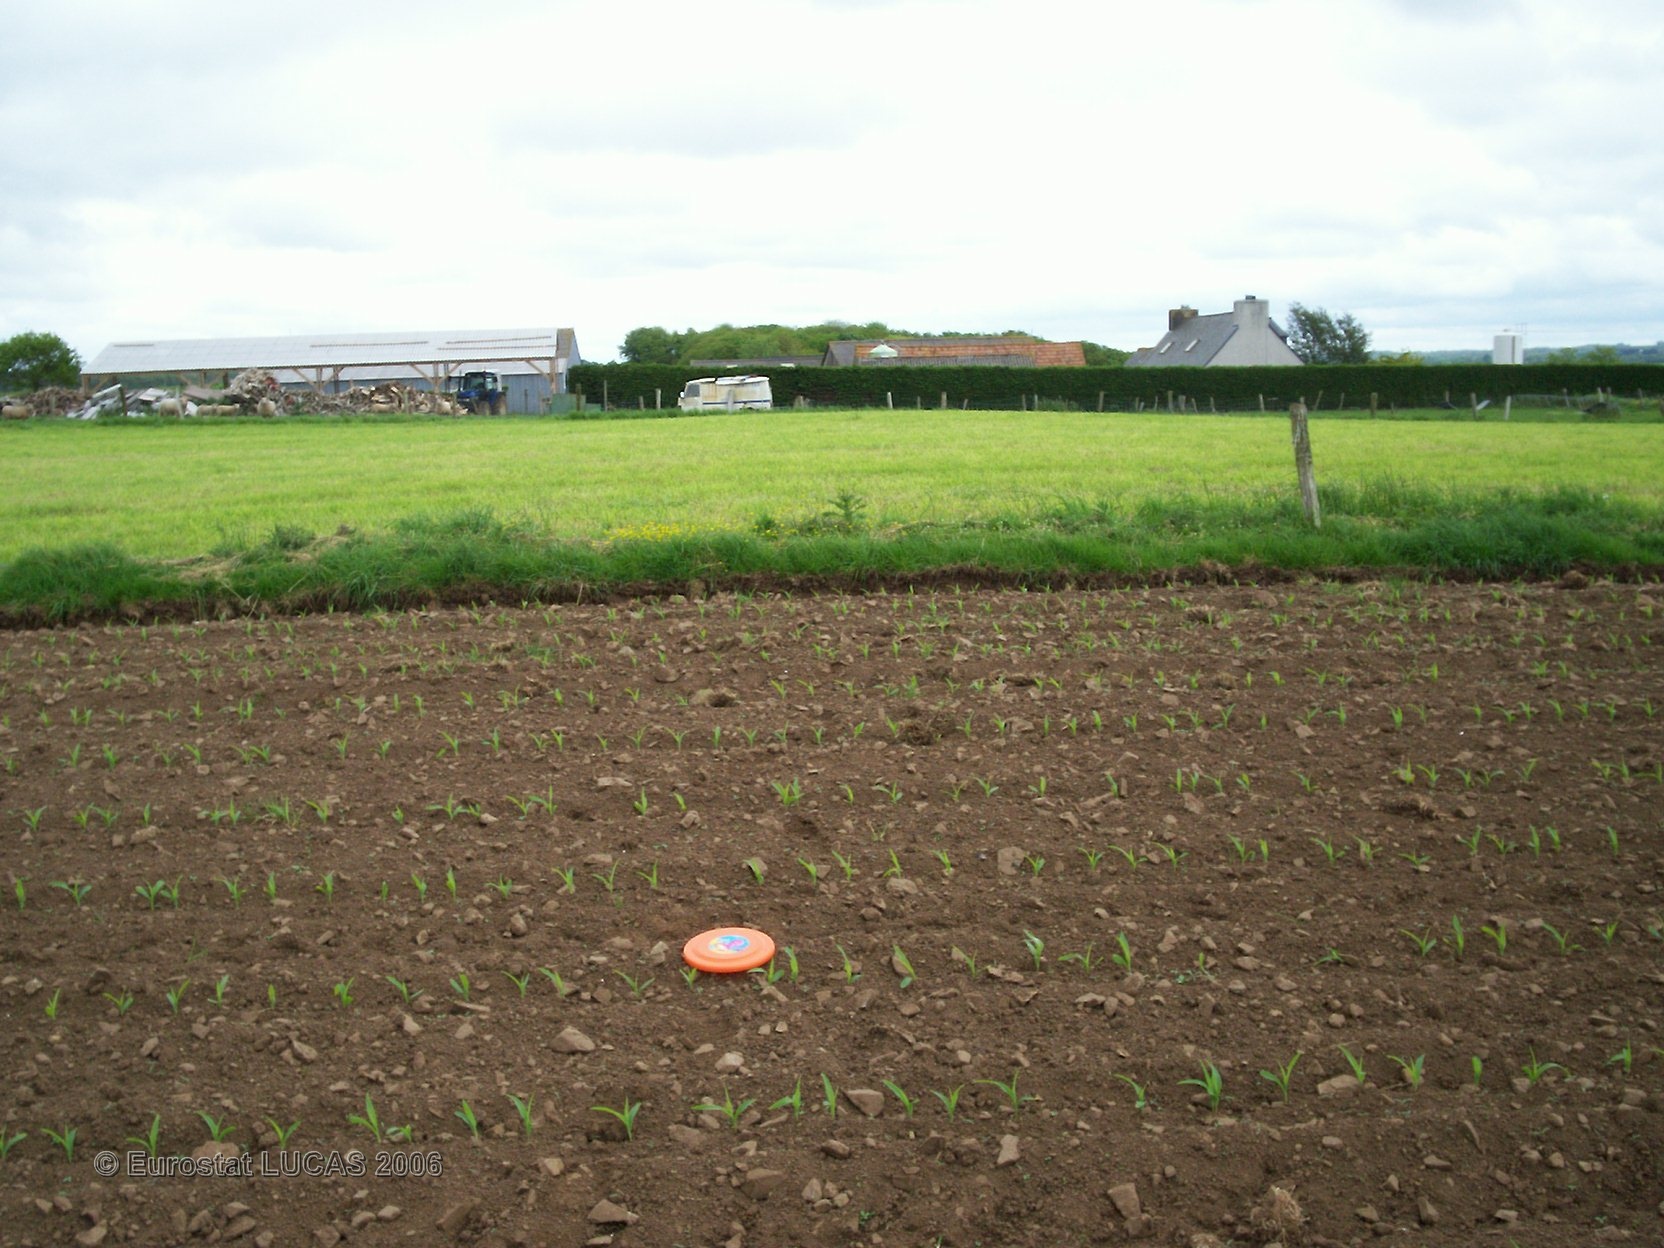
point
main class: Cropland
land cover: Maize
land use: Agriculture (excluding fallow land and kitchen gardens)
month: May
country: FR
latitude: 48.6168
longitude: -3.7440
